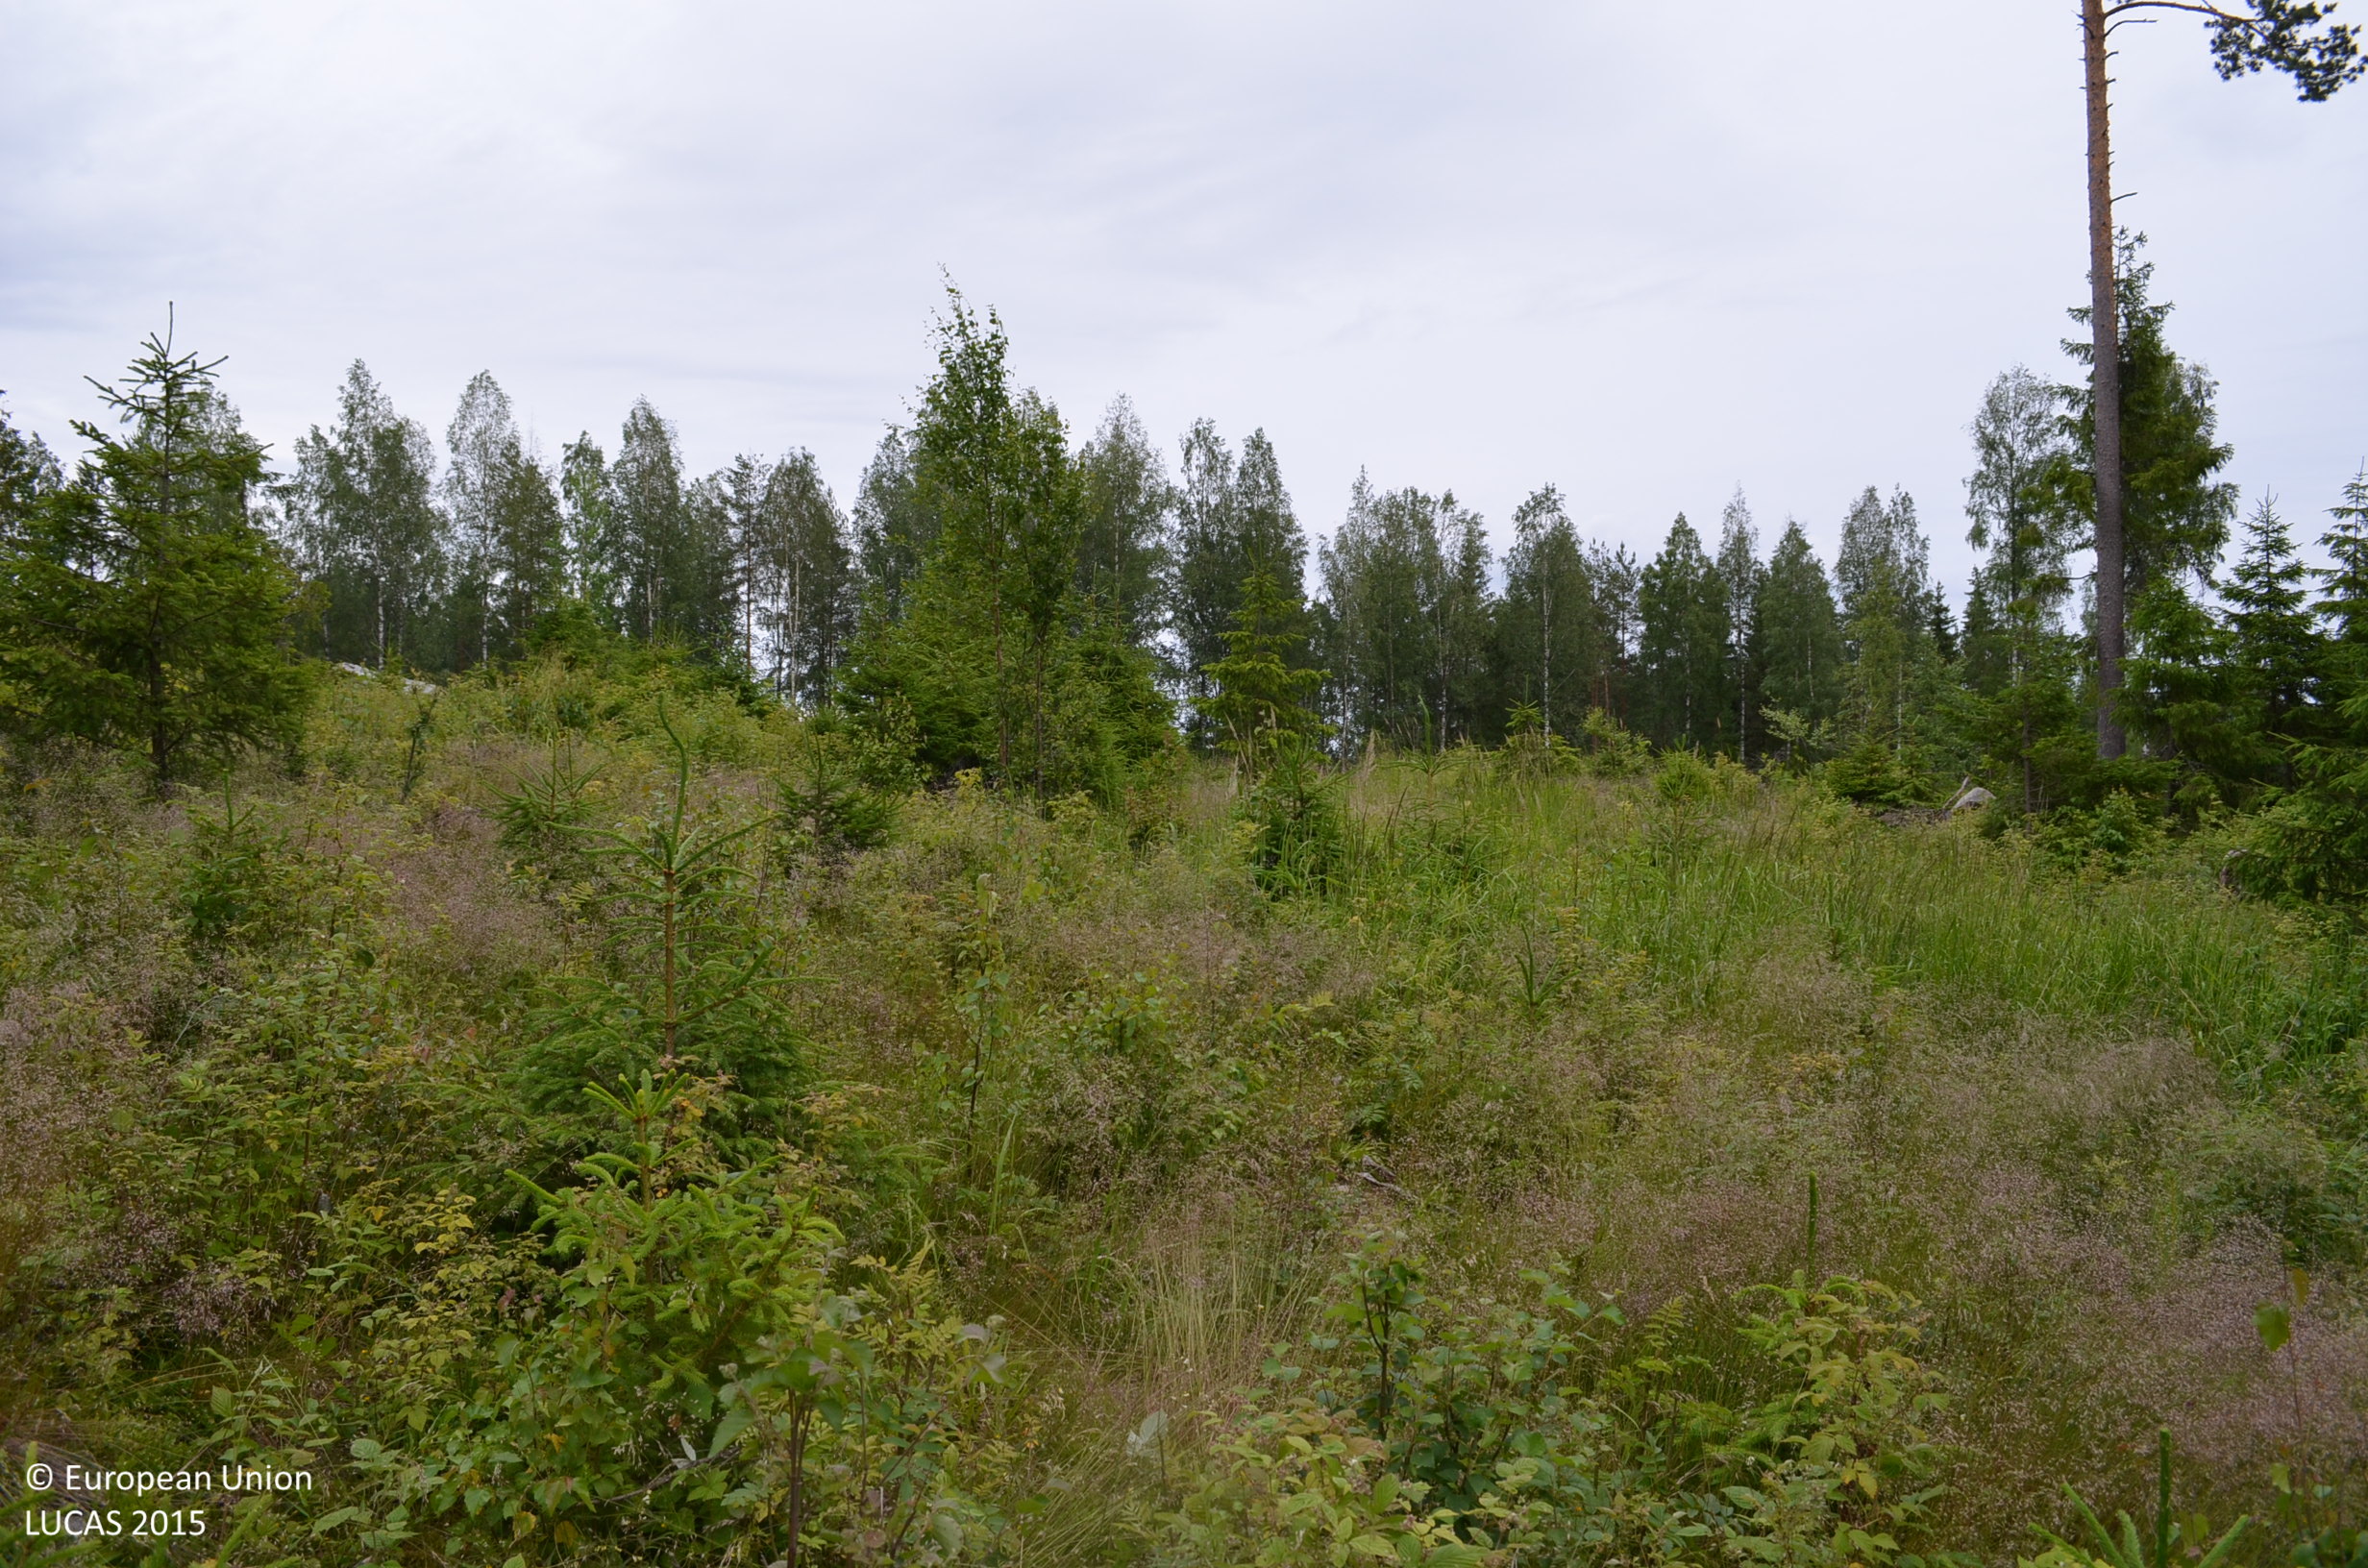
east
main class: Woodland
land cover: Spruce dominated mixed woodland
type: boreal forest
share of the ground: 25 - 50 %
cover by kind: herbaceous plants 60 %, broadleaved forest trees 20 %, coniferous forest trees 15 %, shrubs 5 %
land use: Forestry
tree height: < 5 m
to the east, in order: Spruce dominated mixed woodland; Other mixed woodland; Grassland without tree/shrub cover; Ditches and canals; Grassland without tree/shrub cover; Ditches and canals; Spruce dominated coniferous woodland; Spruce dominated mixed woodland
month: July
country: FI
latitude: 61.6374
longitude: 23.2644
